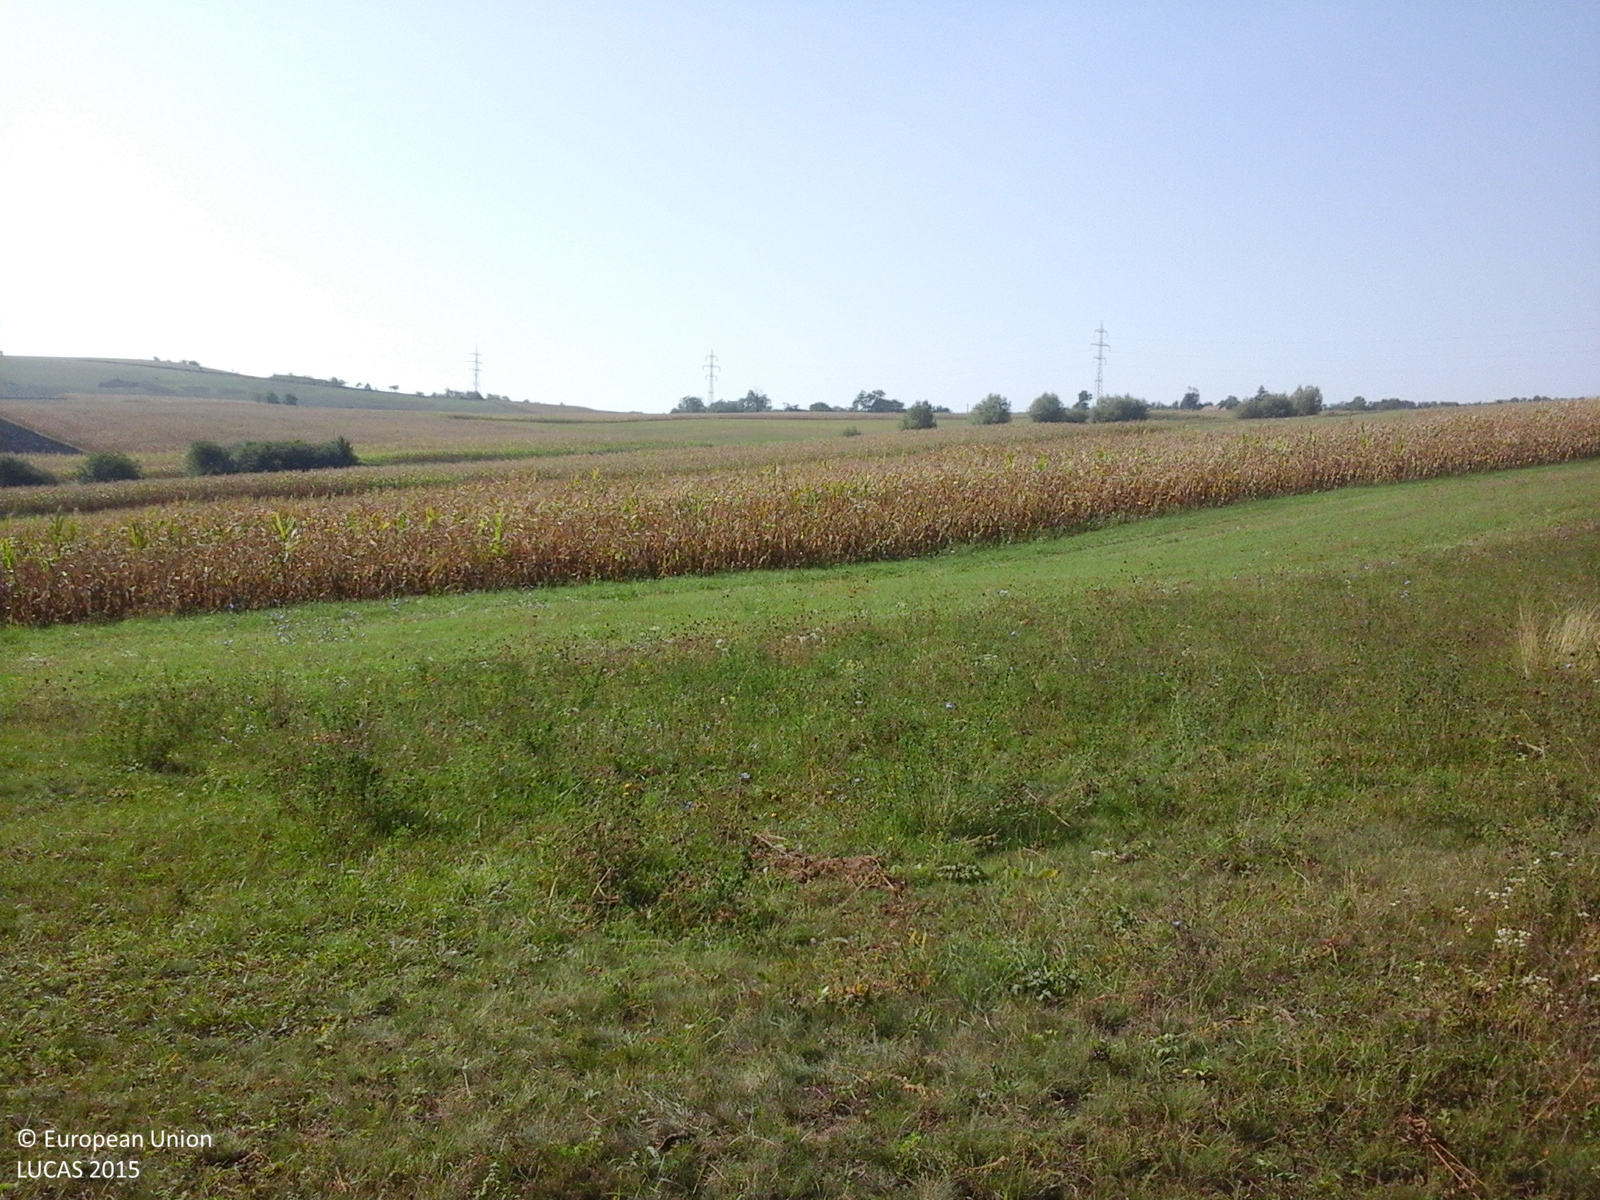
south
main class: Grassland
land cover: Grassland without tree/shrub cover
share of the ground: > 75 %
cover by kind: herbaceous plants 100 %
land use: Agriculture (excluding fallow land and kitchen gardens)
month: September
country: RO
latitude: 46.5514
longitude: 24.0467
